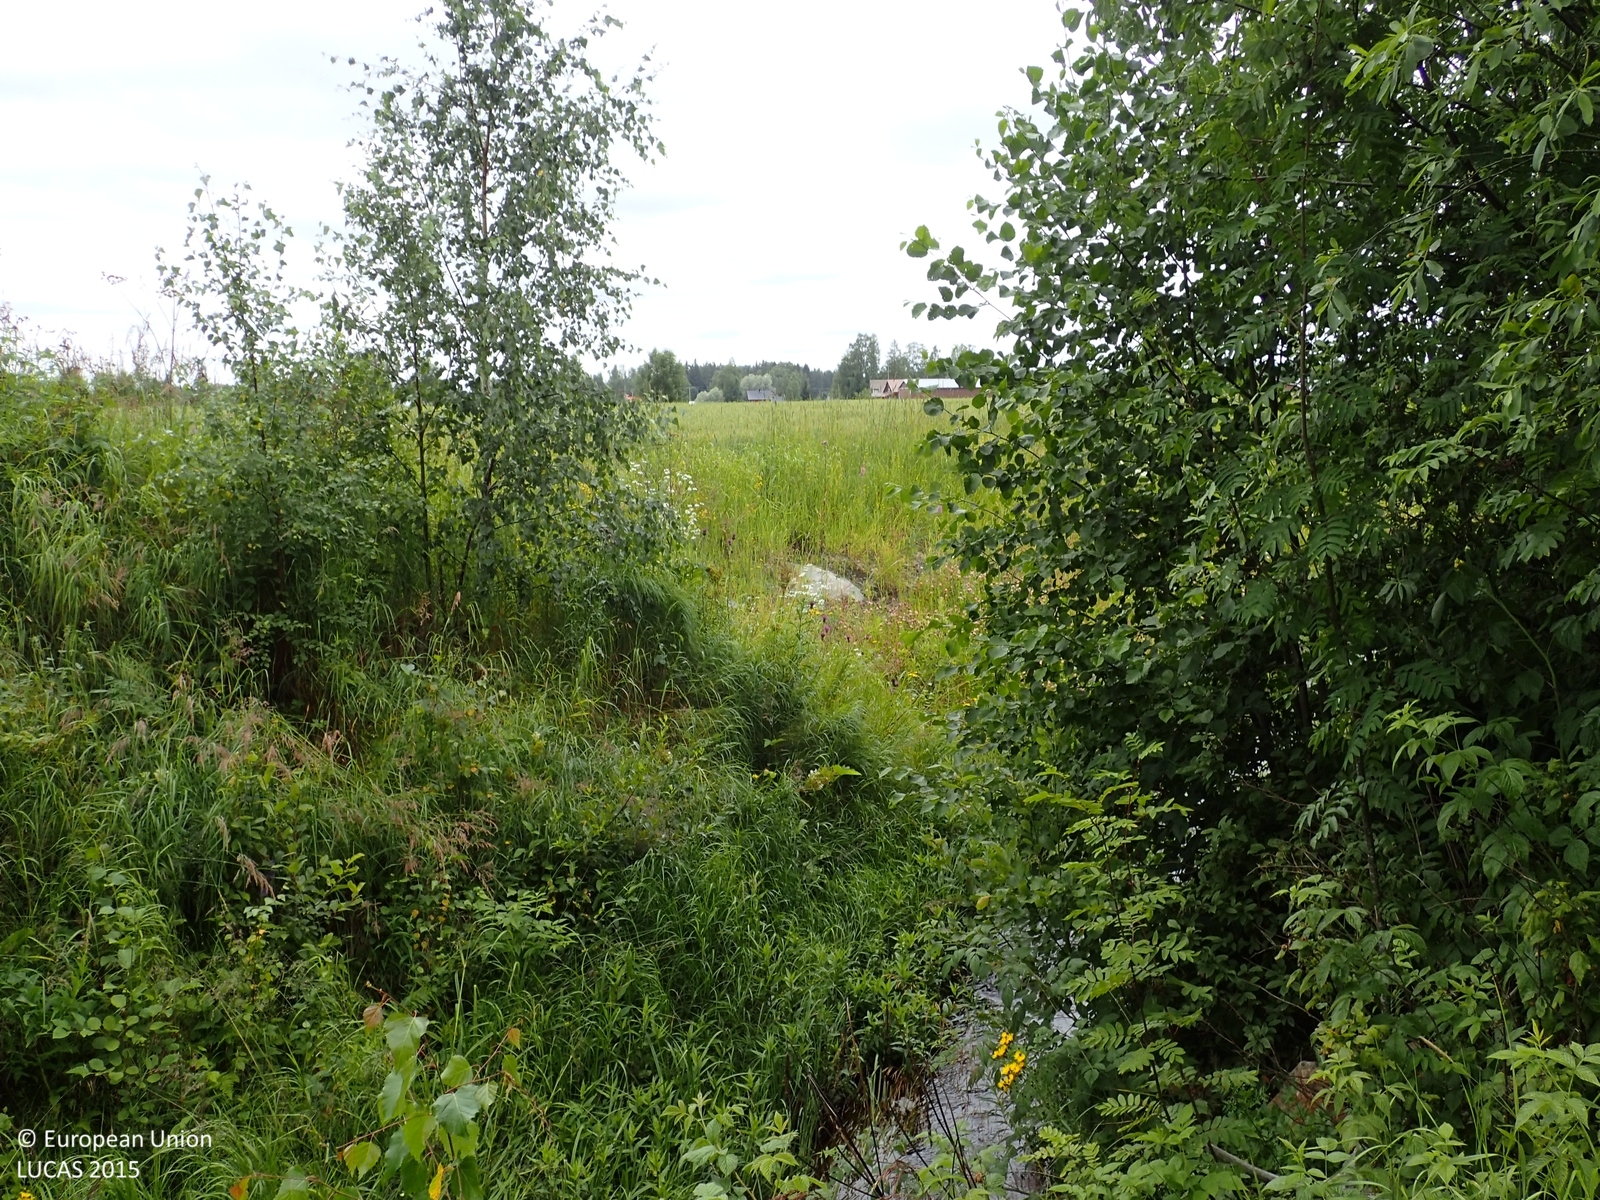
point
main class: Cropland
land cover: Common wheat
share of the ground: > 75 %
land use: Agriculture (excluding fallow land and kitchen gardens)
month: August
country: FI
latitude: 62.9108
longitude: 22.0735
